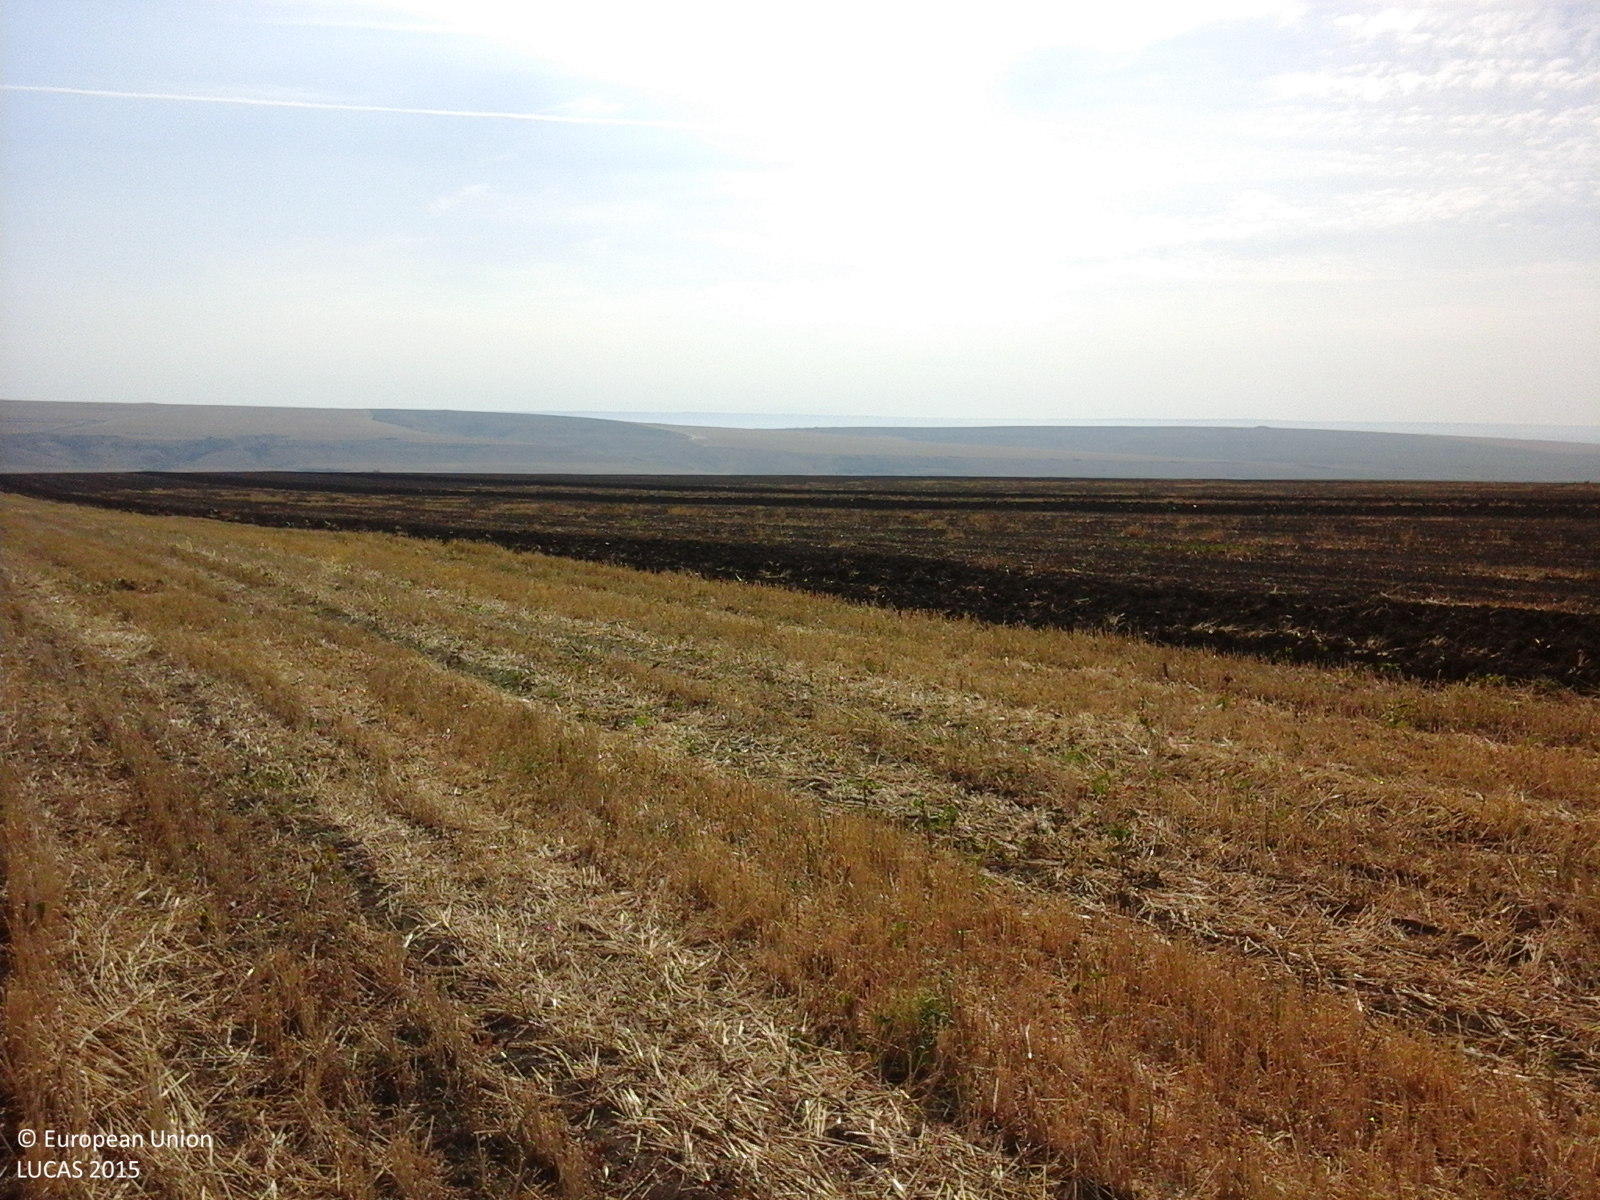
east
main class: Cropland
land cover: Common wheat
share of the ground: > 75 %
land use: Agriculture (excluding fallow land and kitchen gardens)
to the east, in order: Common wheat; Other bare soil
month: July
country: RO
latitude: 46.1485
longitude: 28.0303
